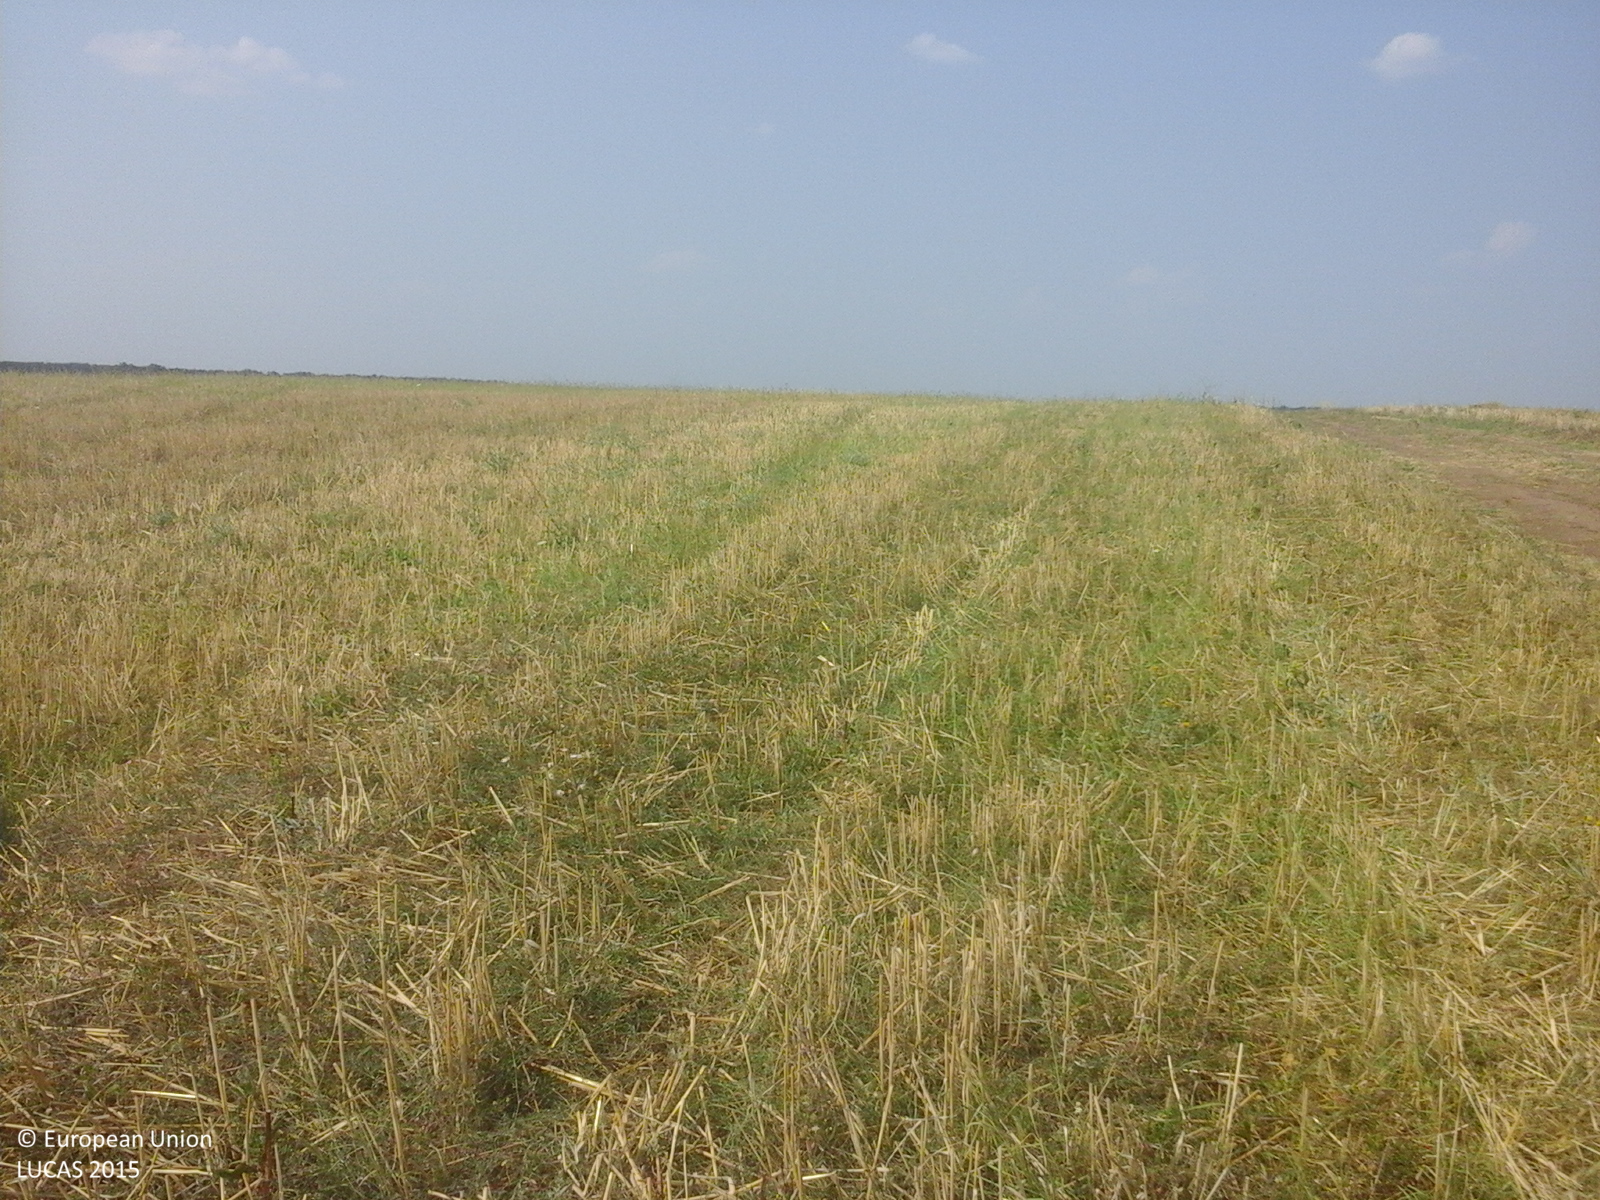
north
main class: Cropland
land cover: Durum wheat
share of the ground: 25 - 50 %
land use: Agriculture (excluding fallow land and kitchen gardens)
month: August
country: RO
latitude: 44.2389
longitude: 23.7154
